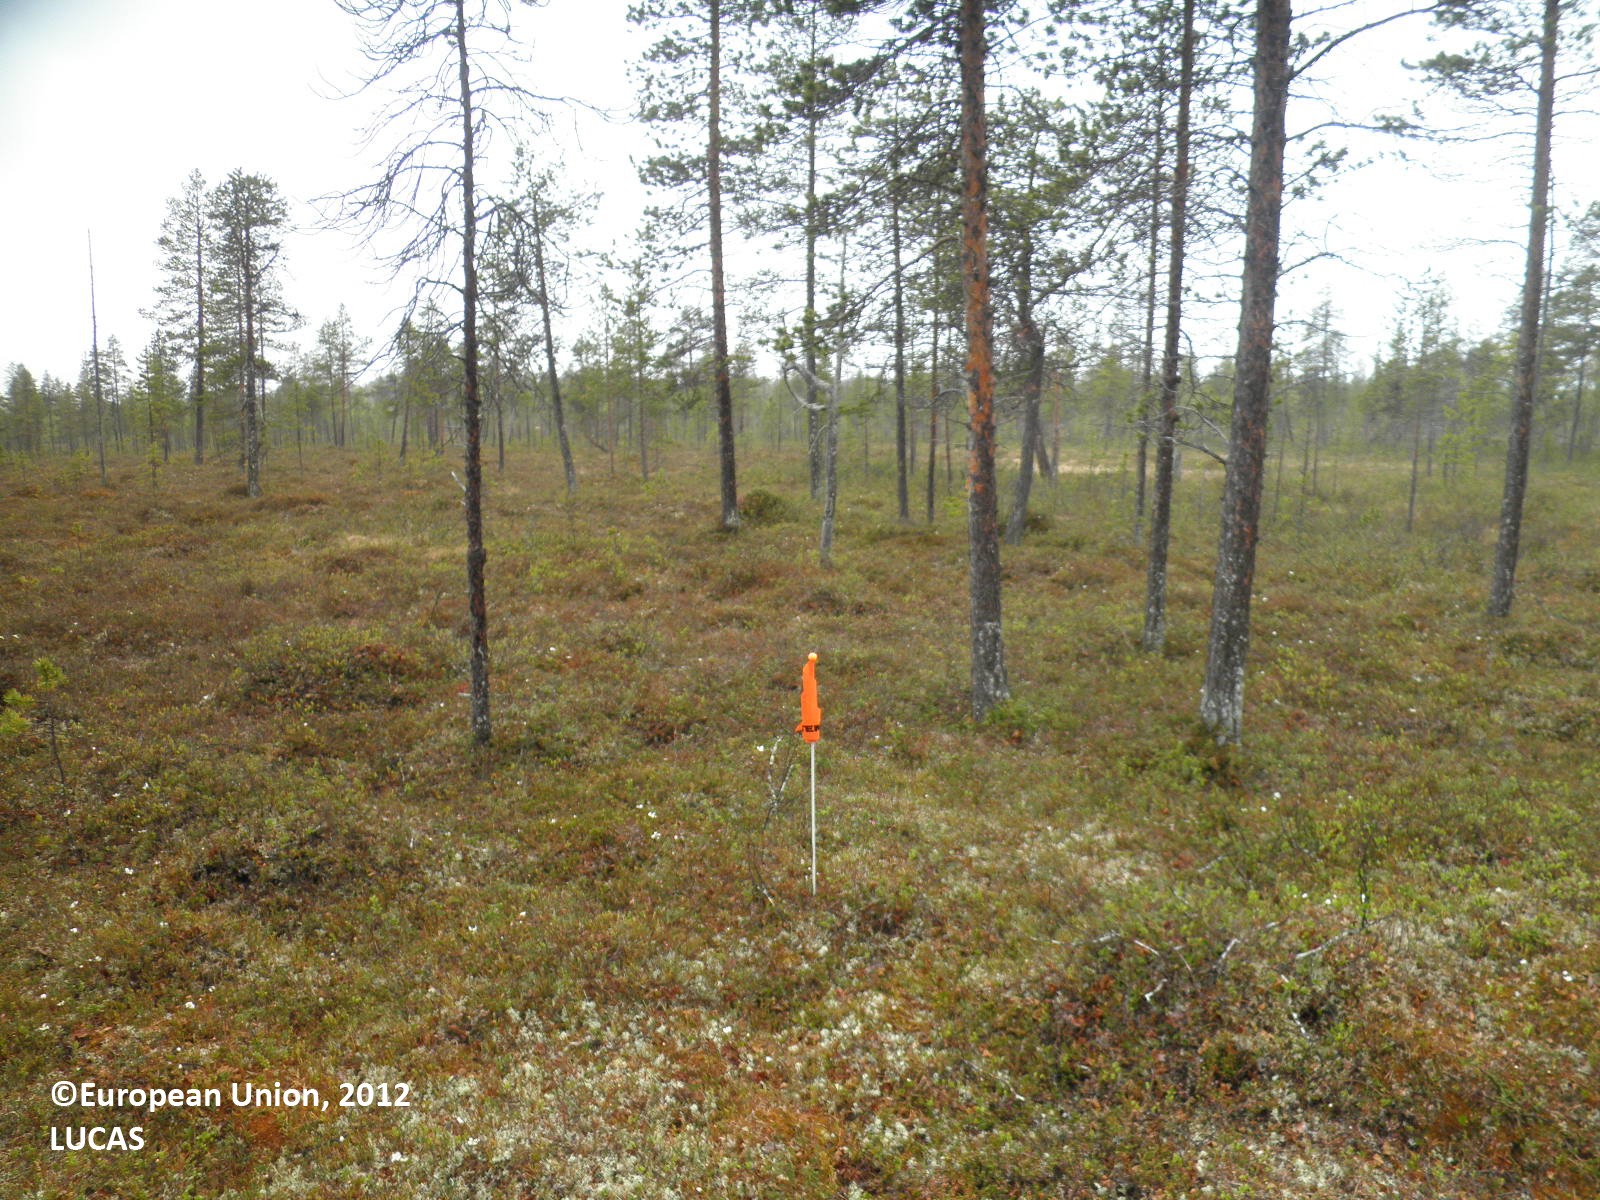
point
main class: Woodland
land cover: Pine dominated coniferous woodland
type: boreal forest
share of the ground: 25 - 50 %
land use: Forestry
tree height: > 5 m
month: June
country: FI
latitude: 68.9019
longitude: 26.5016
